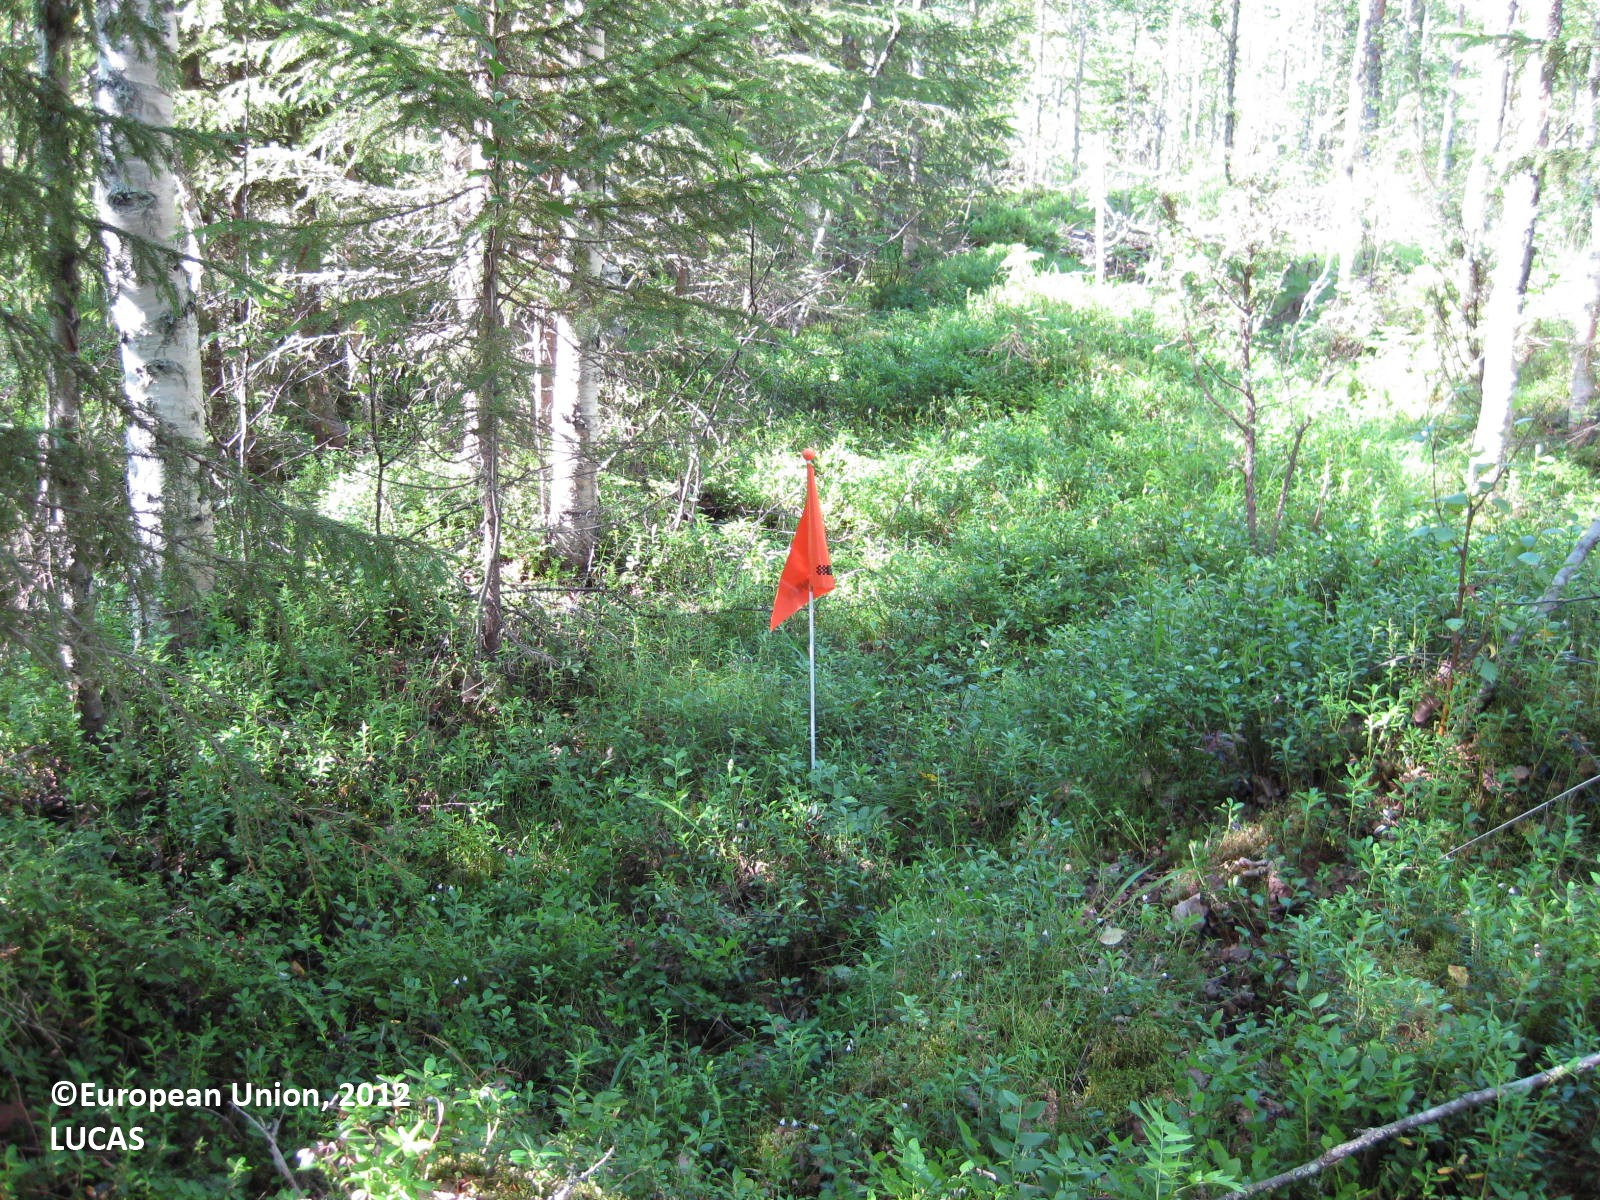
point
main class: Woodland
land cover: Pine dominated mixed woodland
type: boreal forest
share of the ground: 50 - 75 %
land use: Forestry
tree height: > 5 m
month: July
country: FI
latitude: 65.5775
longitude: 28.4753
